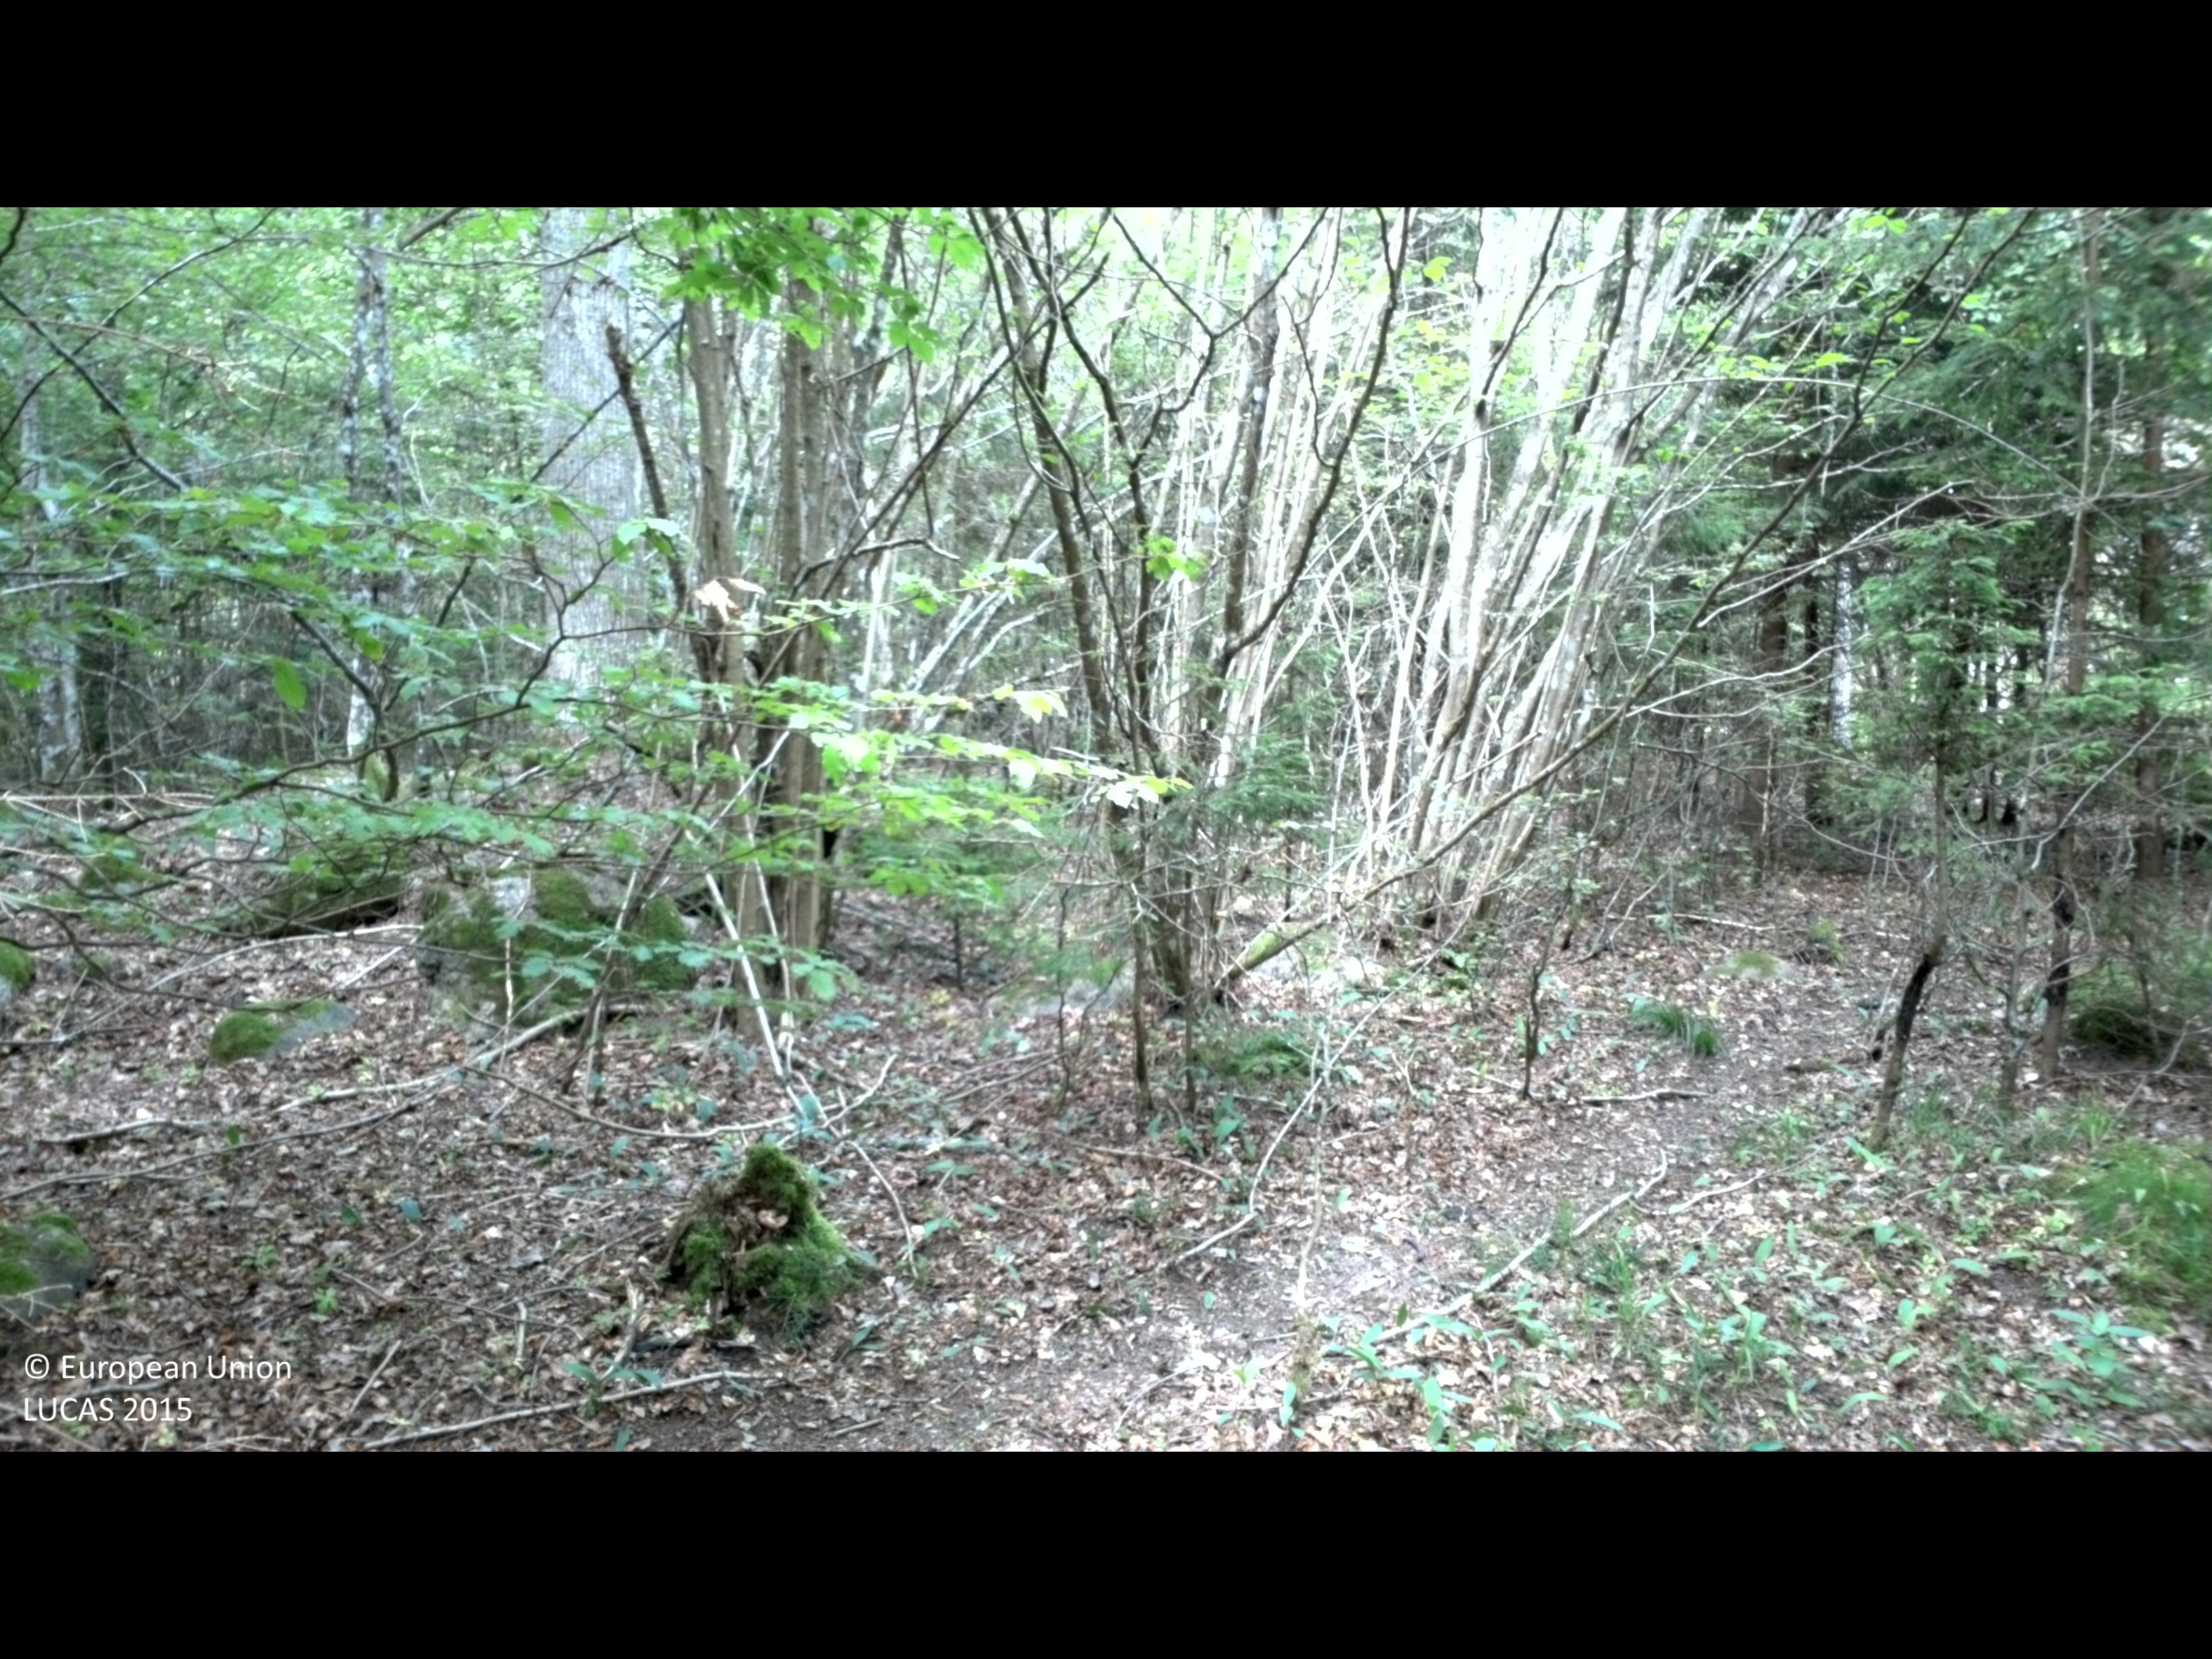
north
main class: Woodland
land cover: Broadleaved woodland
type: mesophytic deciduous forest
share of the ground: 50 - 75 %
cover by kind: broadleaved forest trees 50 %, shrubs 30 %, herbaceous plants 15 %, coniferous forest trees 5 %
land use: Forestry
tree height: > 5 m
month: July
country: SE
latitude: 56.2528
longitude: 15.4387
